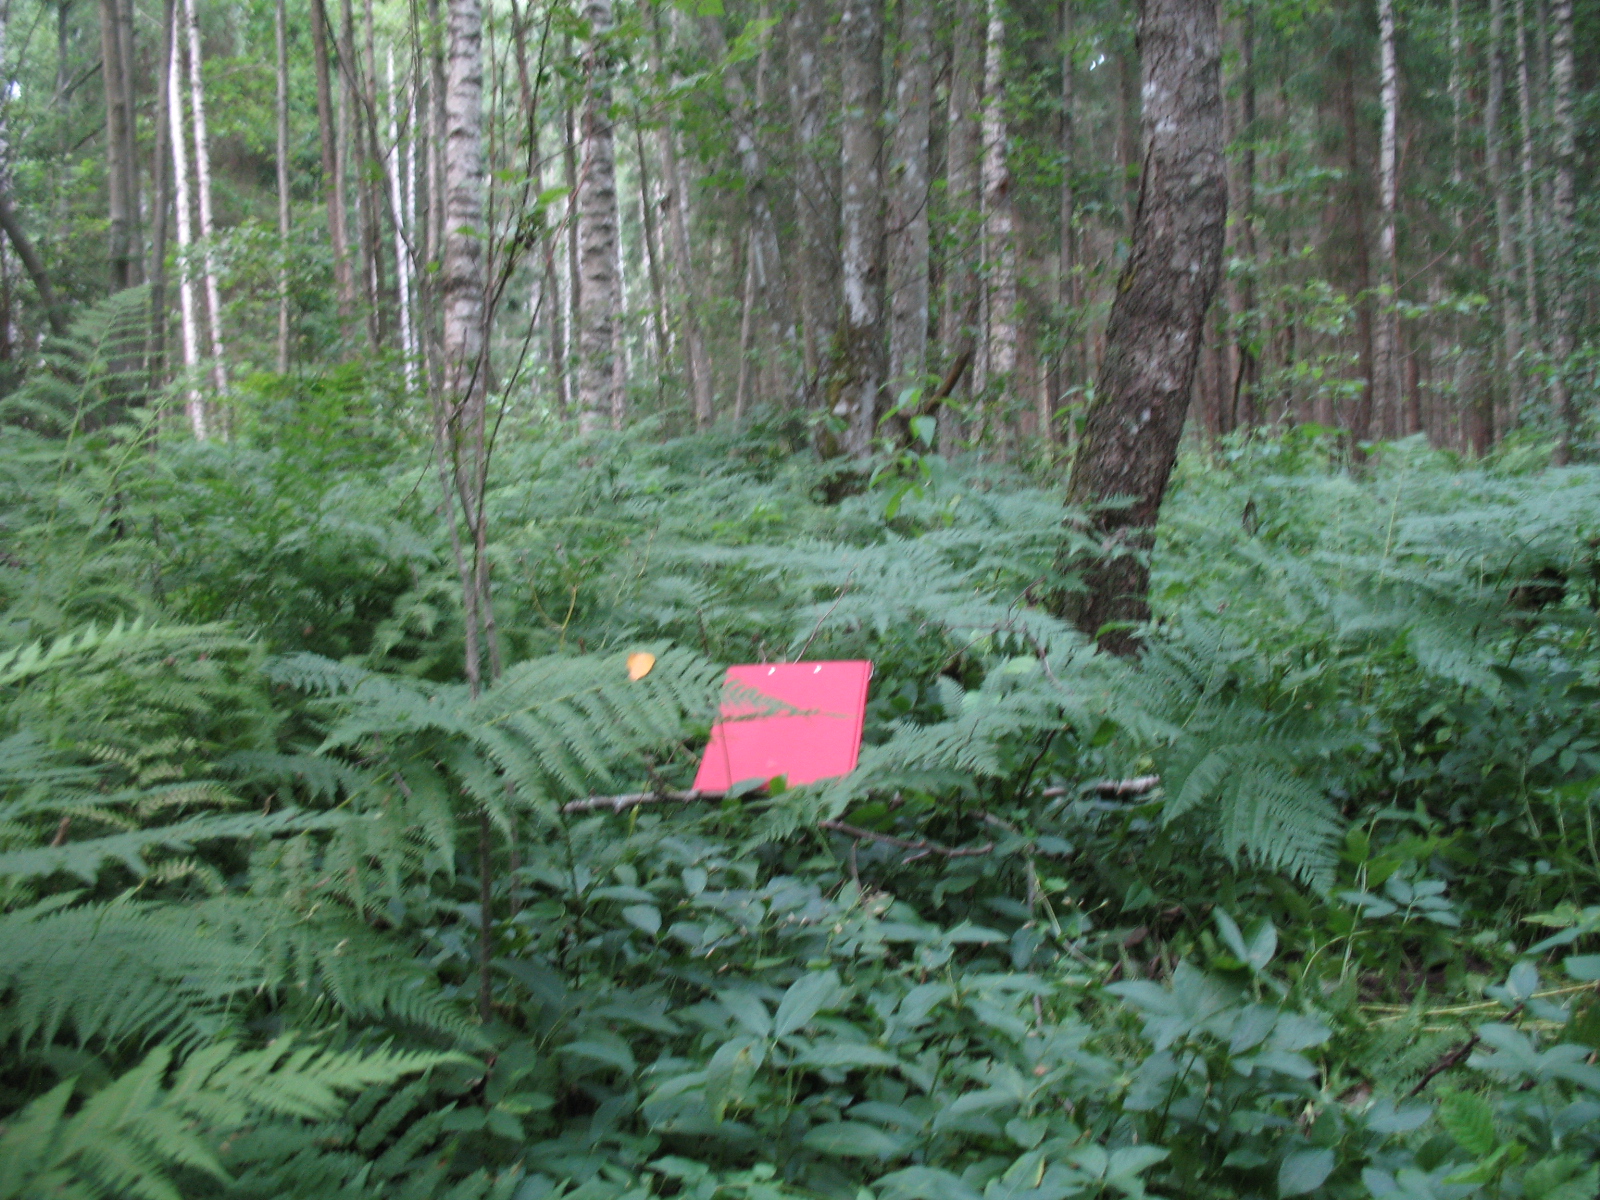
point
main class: Woodland
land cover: Broadleaved woodland
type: non-riverine alder, birch or aspen forest
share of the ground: > 75 %
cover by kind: broadleaved forest trees 80 %, herbaceous plants 10 %, coniferous forest trees 5 %, shrubs 5 %
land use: Forestry
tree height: > 5 m
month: July
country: LV
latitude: 56.4126
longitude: 25.0365
